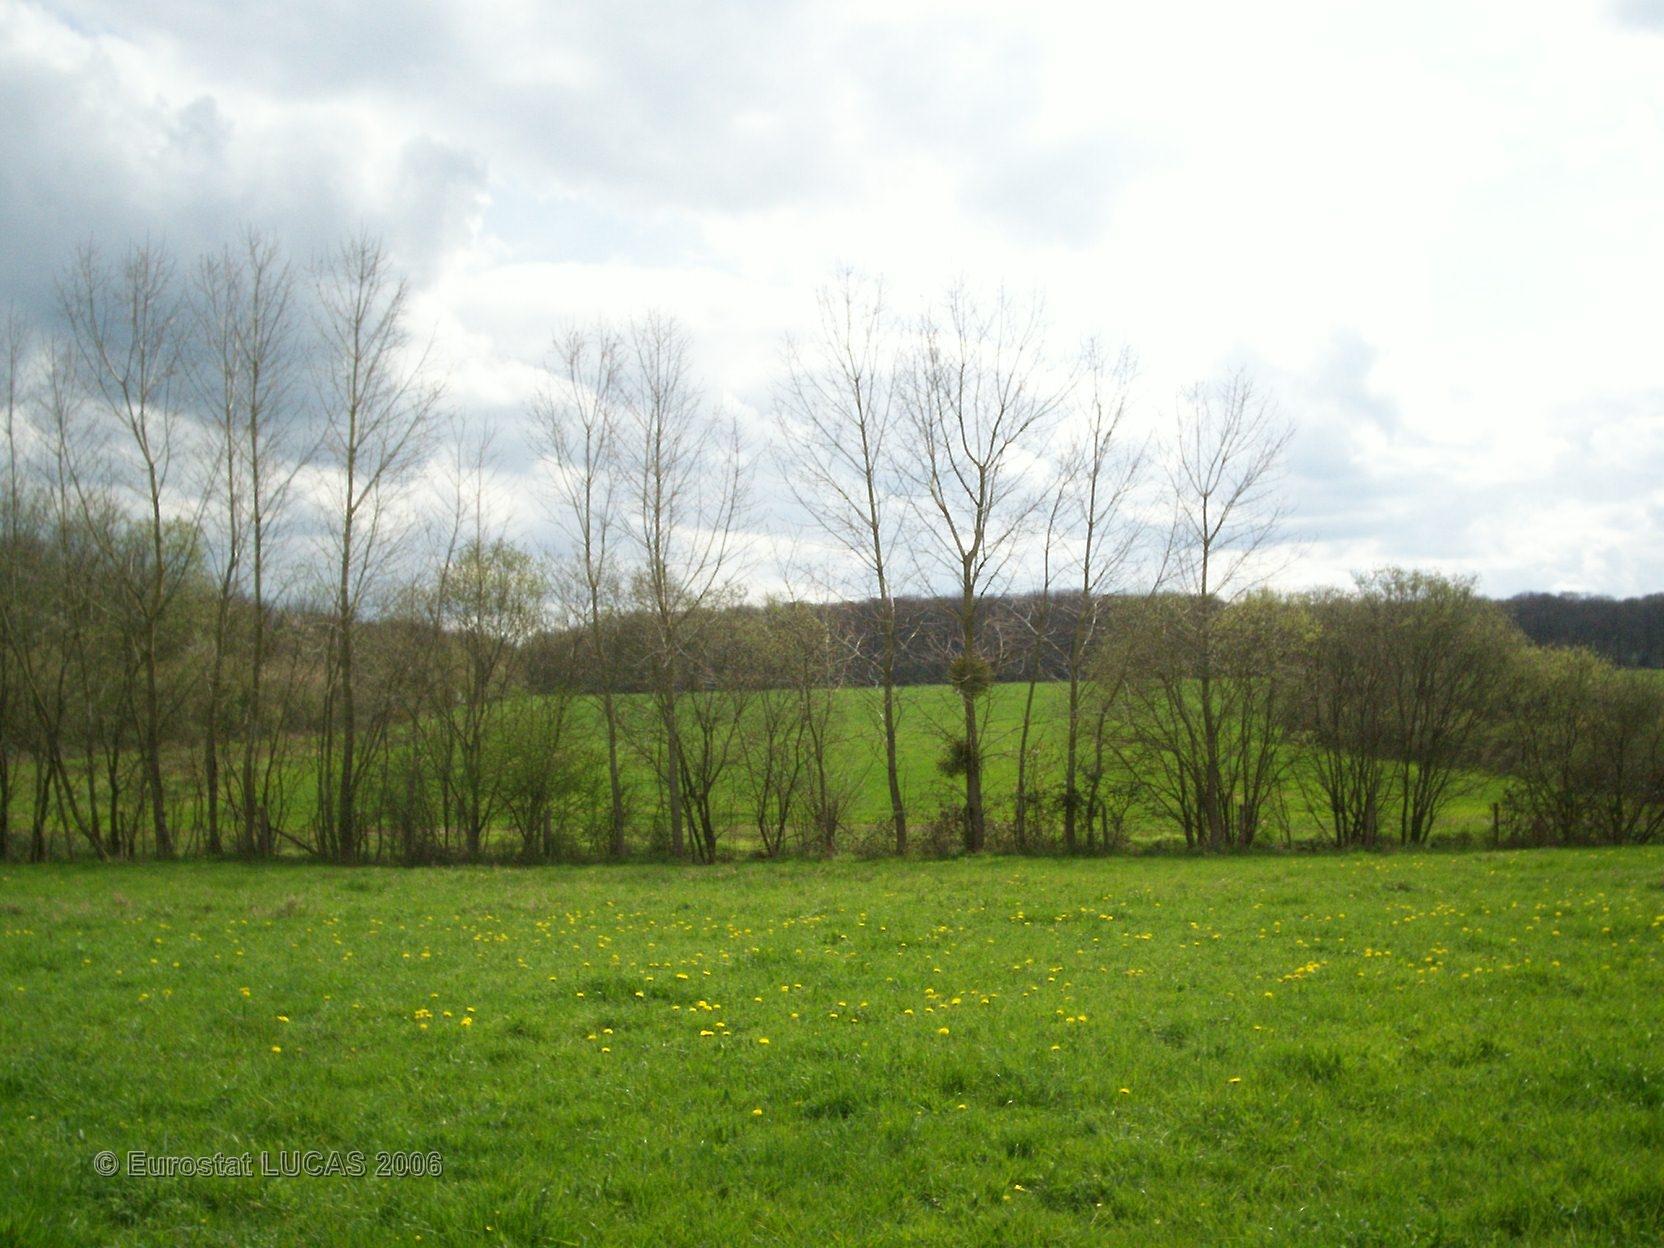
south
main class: Grassland
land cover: Grassland without tree/shrub cover
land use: Agriculture (excluding fallow land and kitchen gardens)
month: April
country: FR
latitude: 47.9116
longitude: -0.5904
